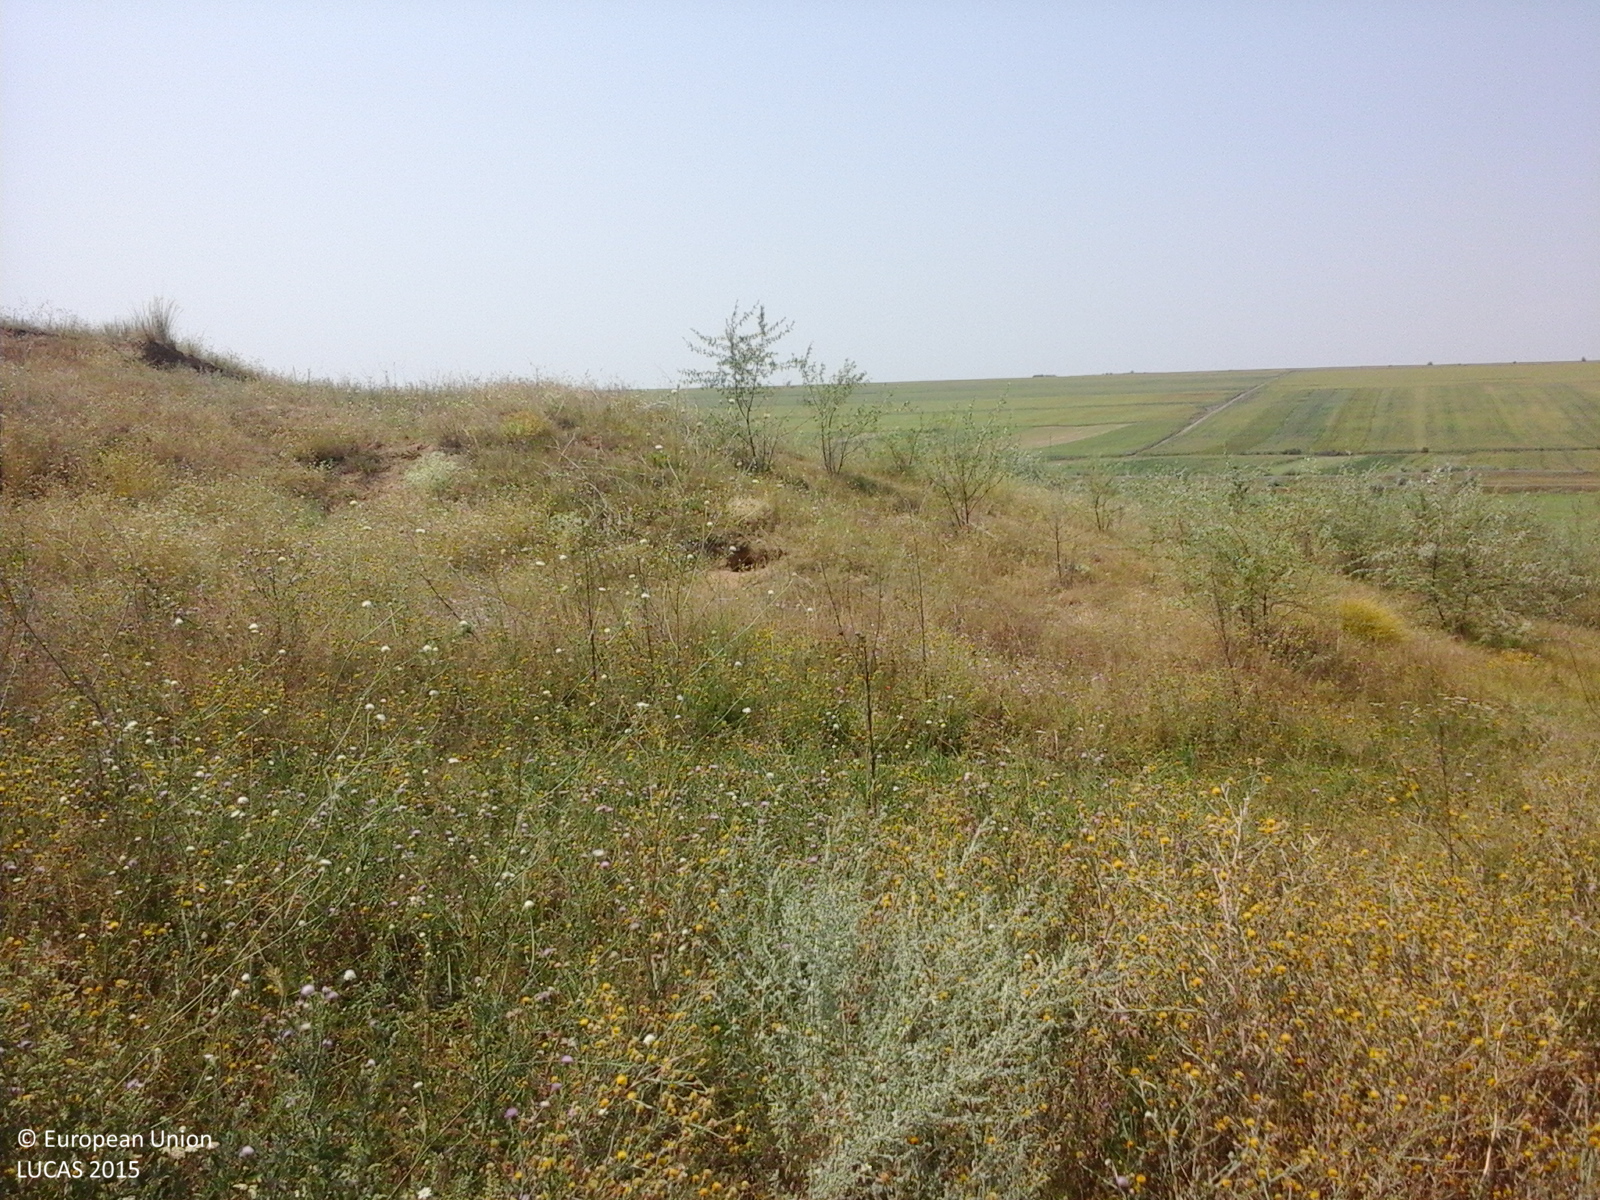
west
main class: Grassland
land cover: Grassland with sparse tree/shrub cover
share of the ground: > 75 %
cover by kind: herbaceous plants 90 %, broadleaved forest trees 5 %, shrubs 5 %
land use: Fallow land
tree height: < 5 m
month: July
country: RO
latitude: 45.6868
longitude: 27.8204
